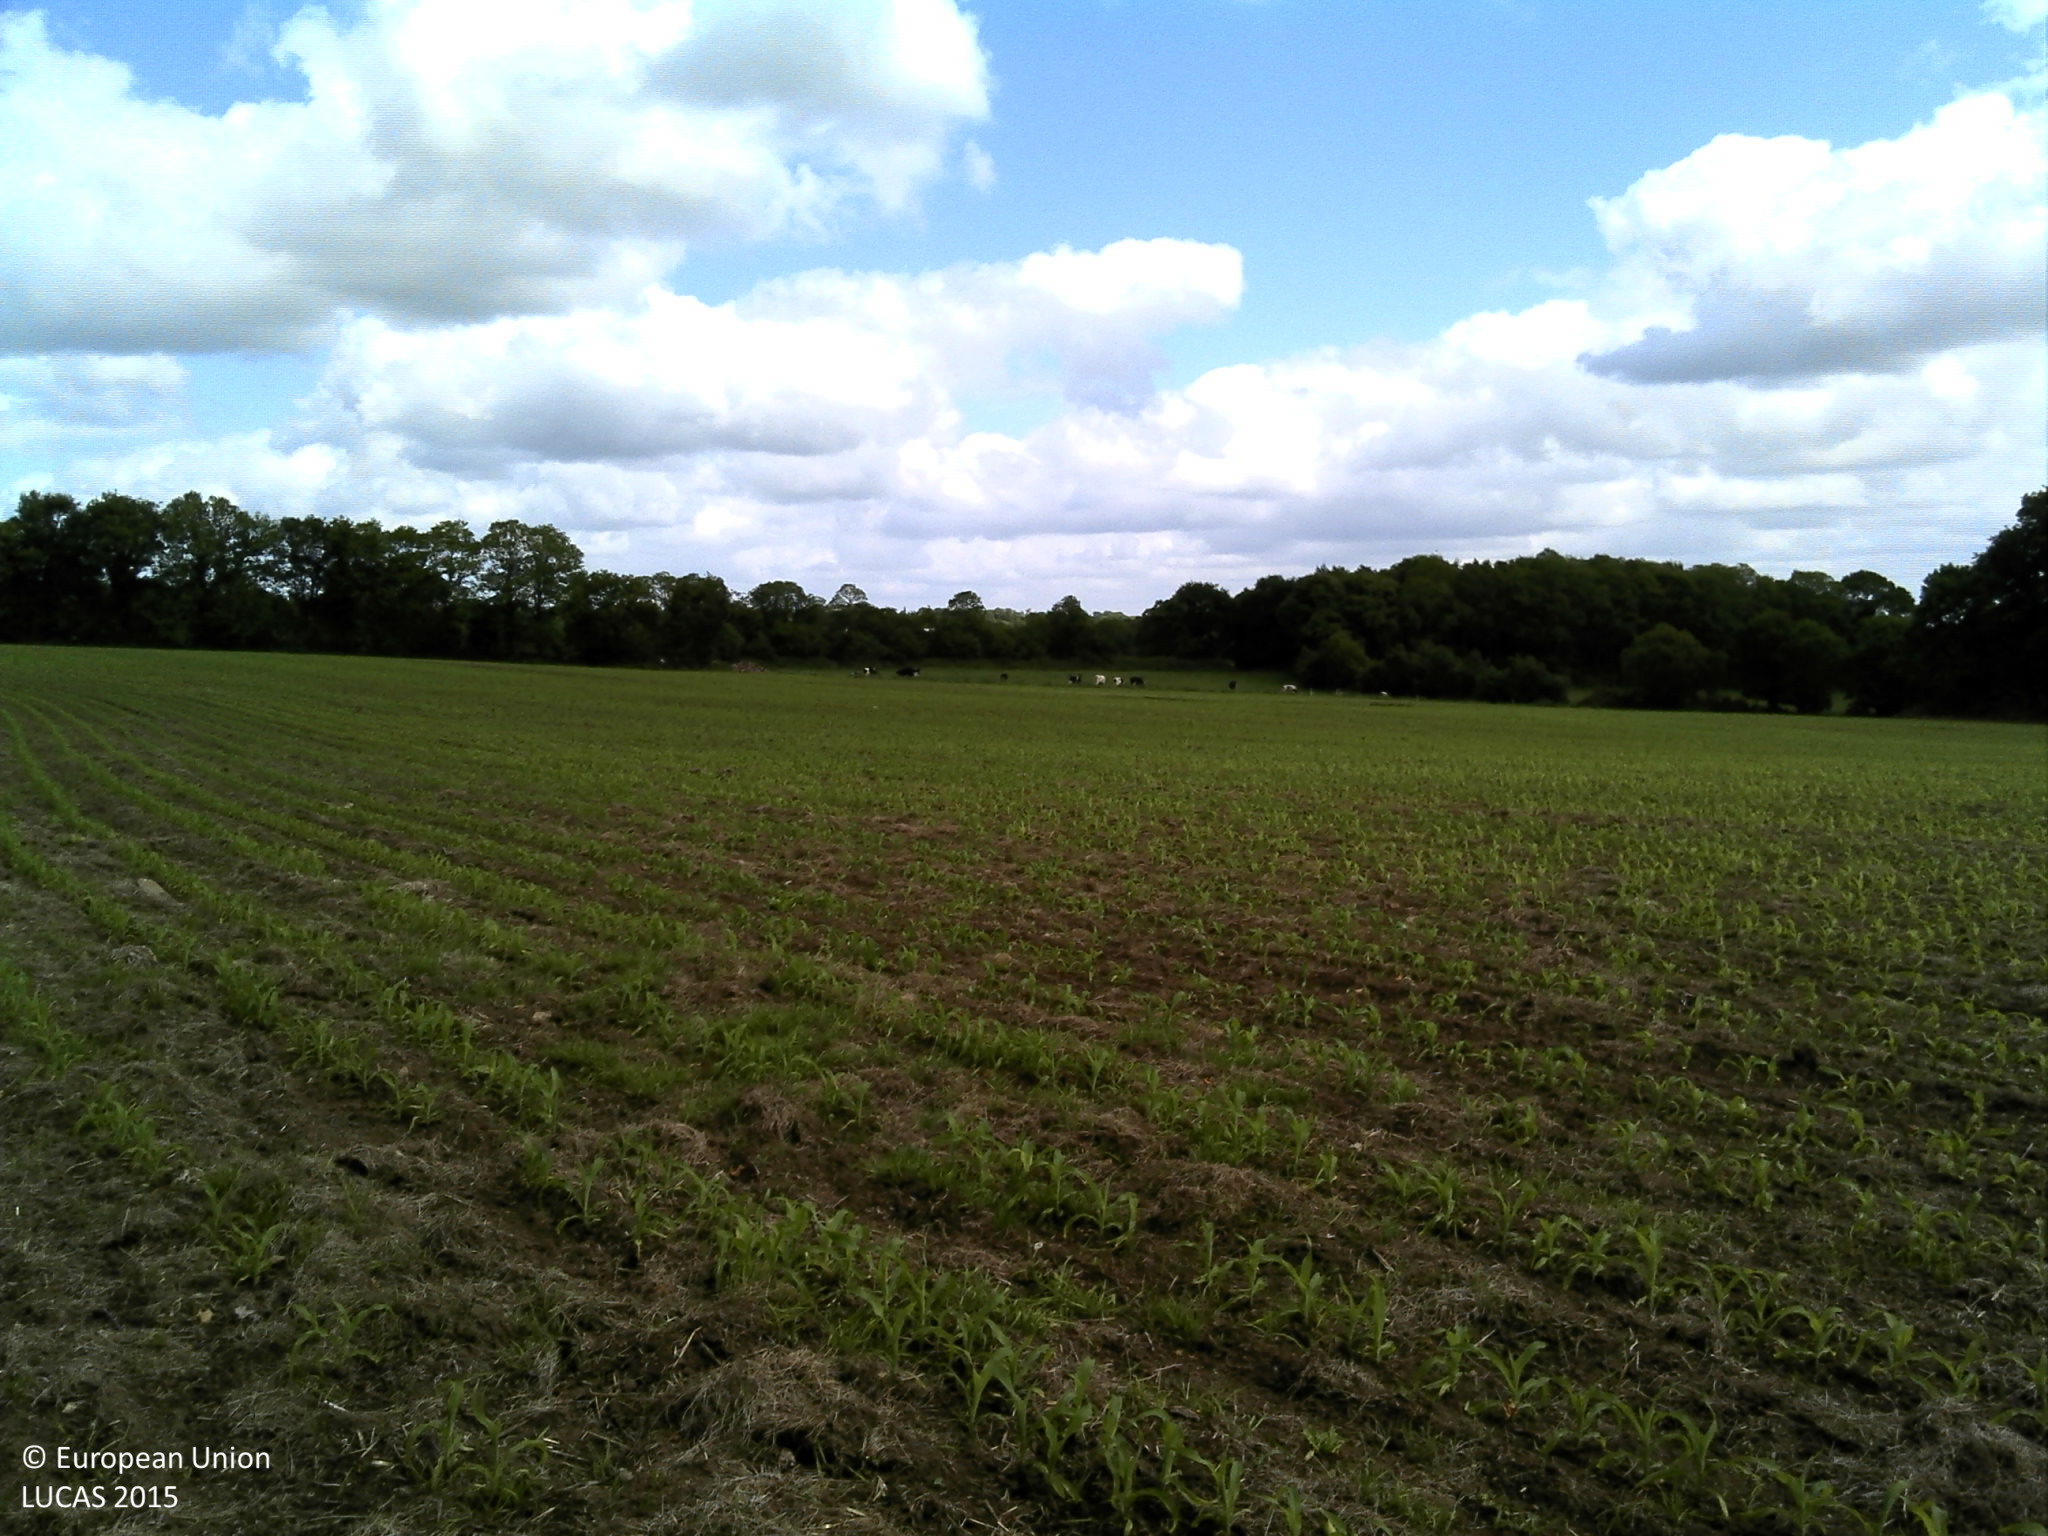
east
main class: Cropland
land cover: Maize
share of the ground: 10 - 25 %
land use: Agriculture (excluding fallow land and kitchen gardens)
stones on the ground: 10 - 25 %
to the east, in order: Maize; Fences; Grassland without tree/shrub cover
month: June
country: FR
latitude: 47.9608
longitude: -3.5911
